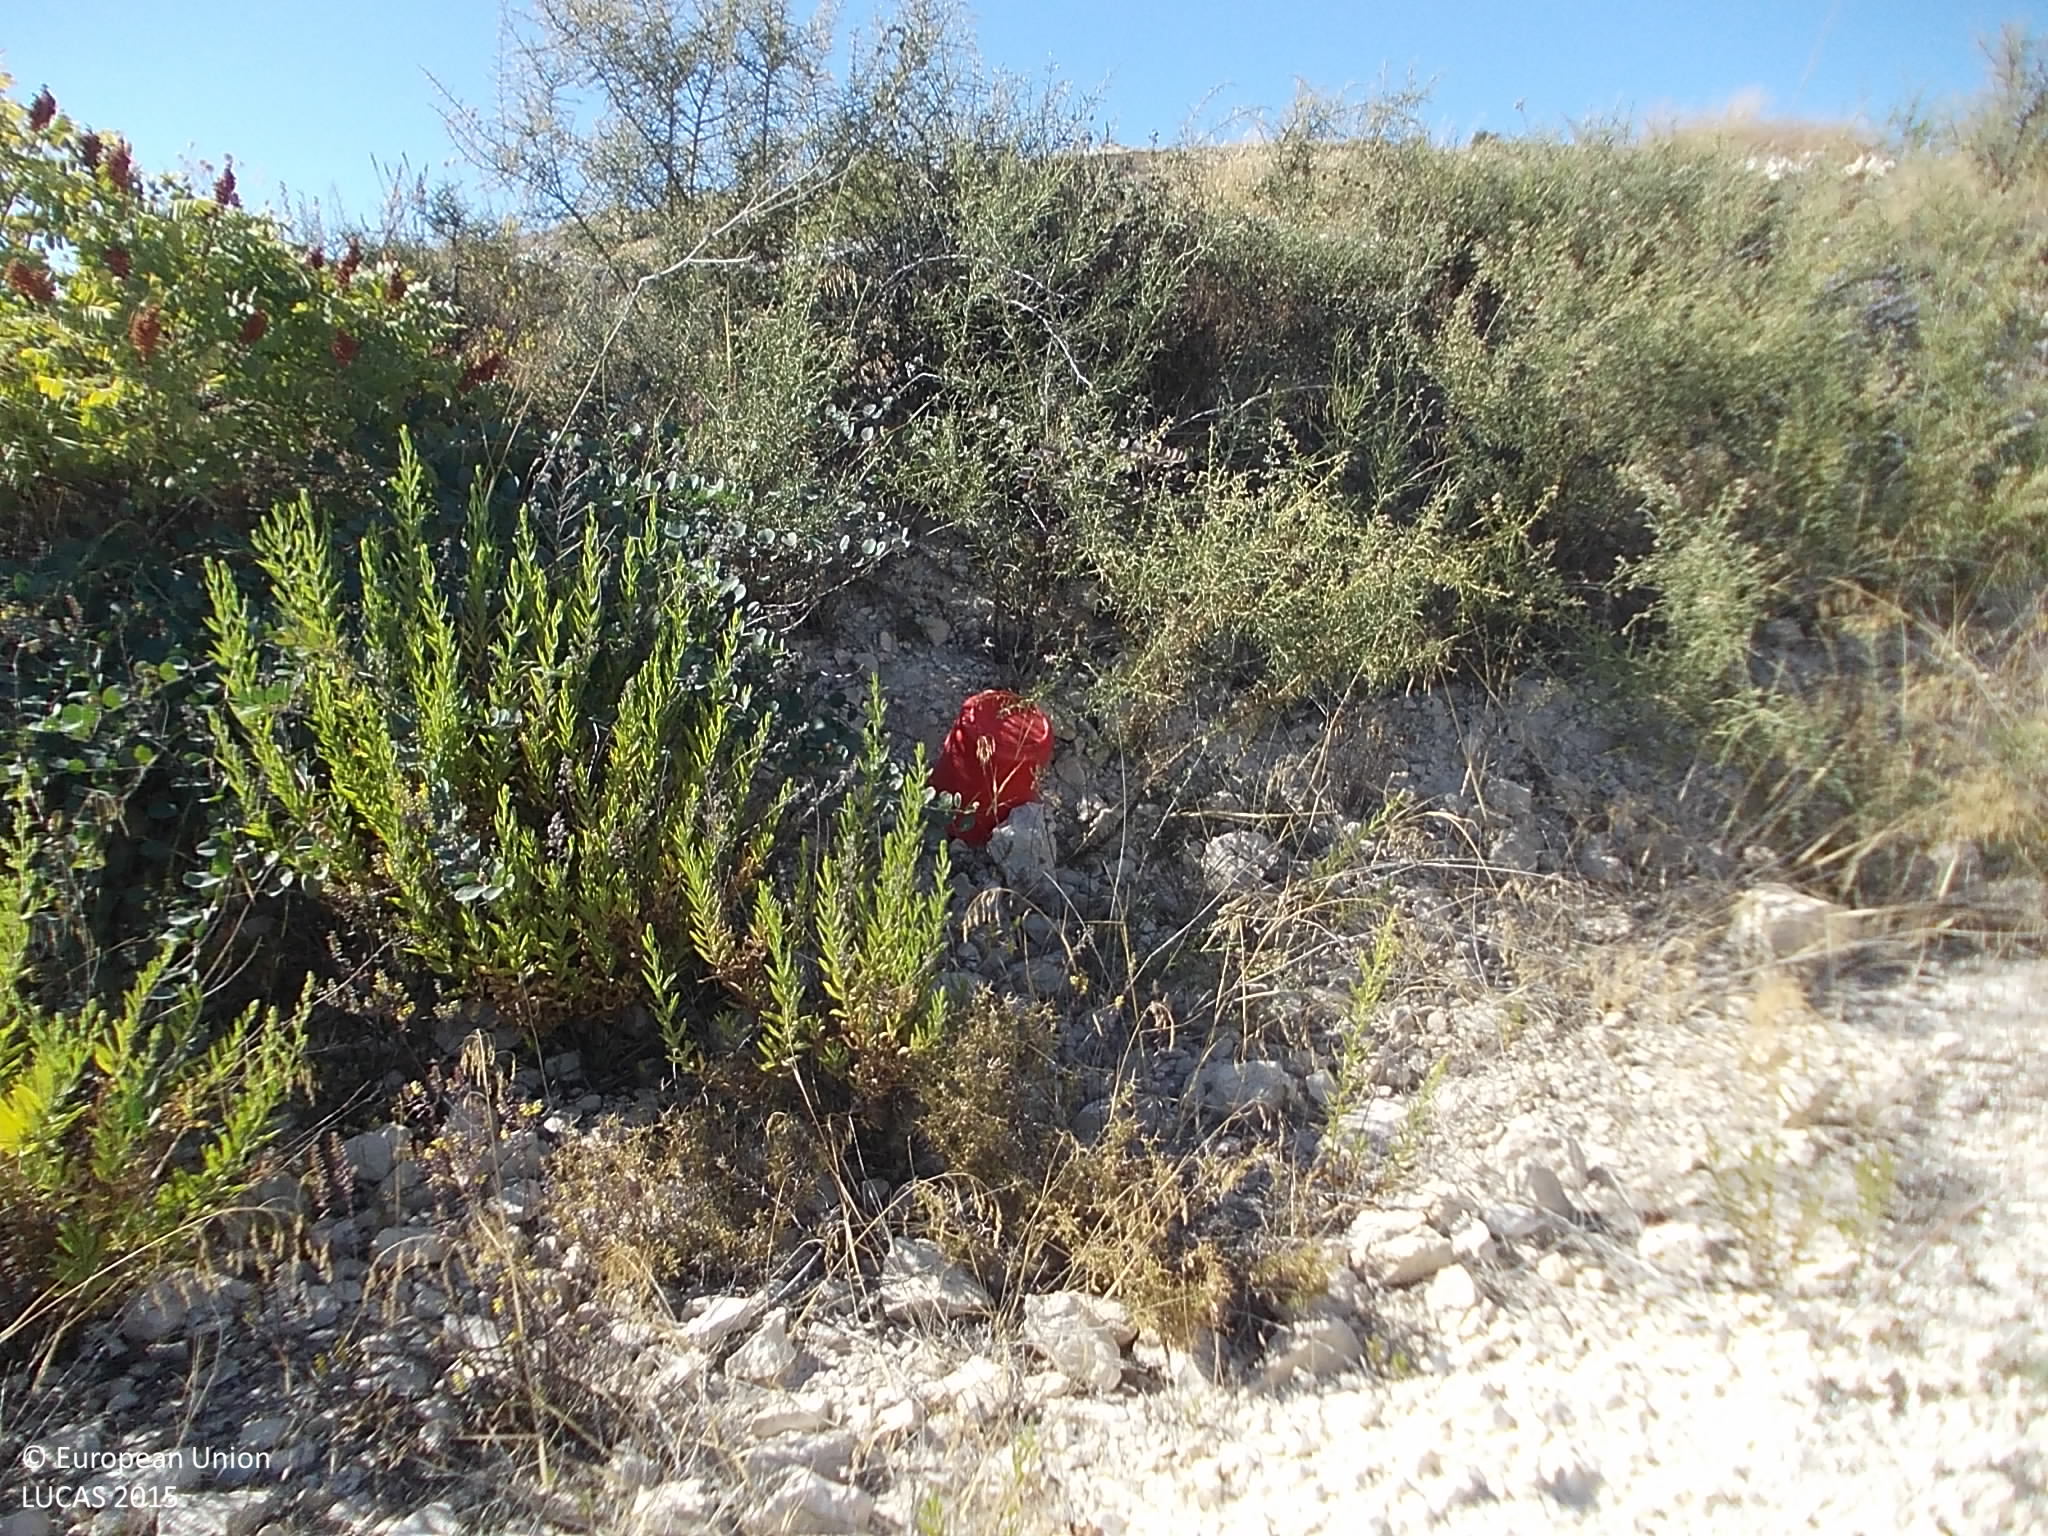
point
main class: Cropland
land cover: Vineyards
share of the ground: 10 - 25 %
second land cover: Rocks and stones
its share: > 75 %
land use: Agriculture (excluding fallow land and kitchen gardens)
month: July
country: CY
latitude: 34.8531
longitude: 32.7673
